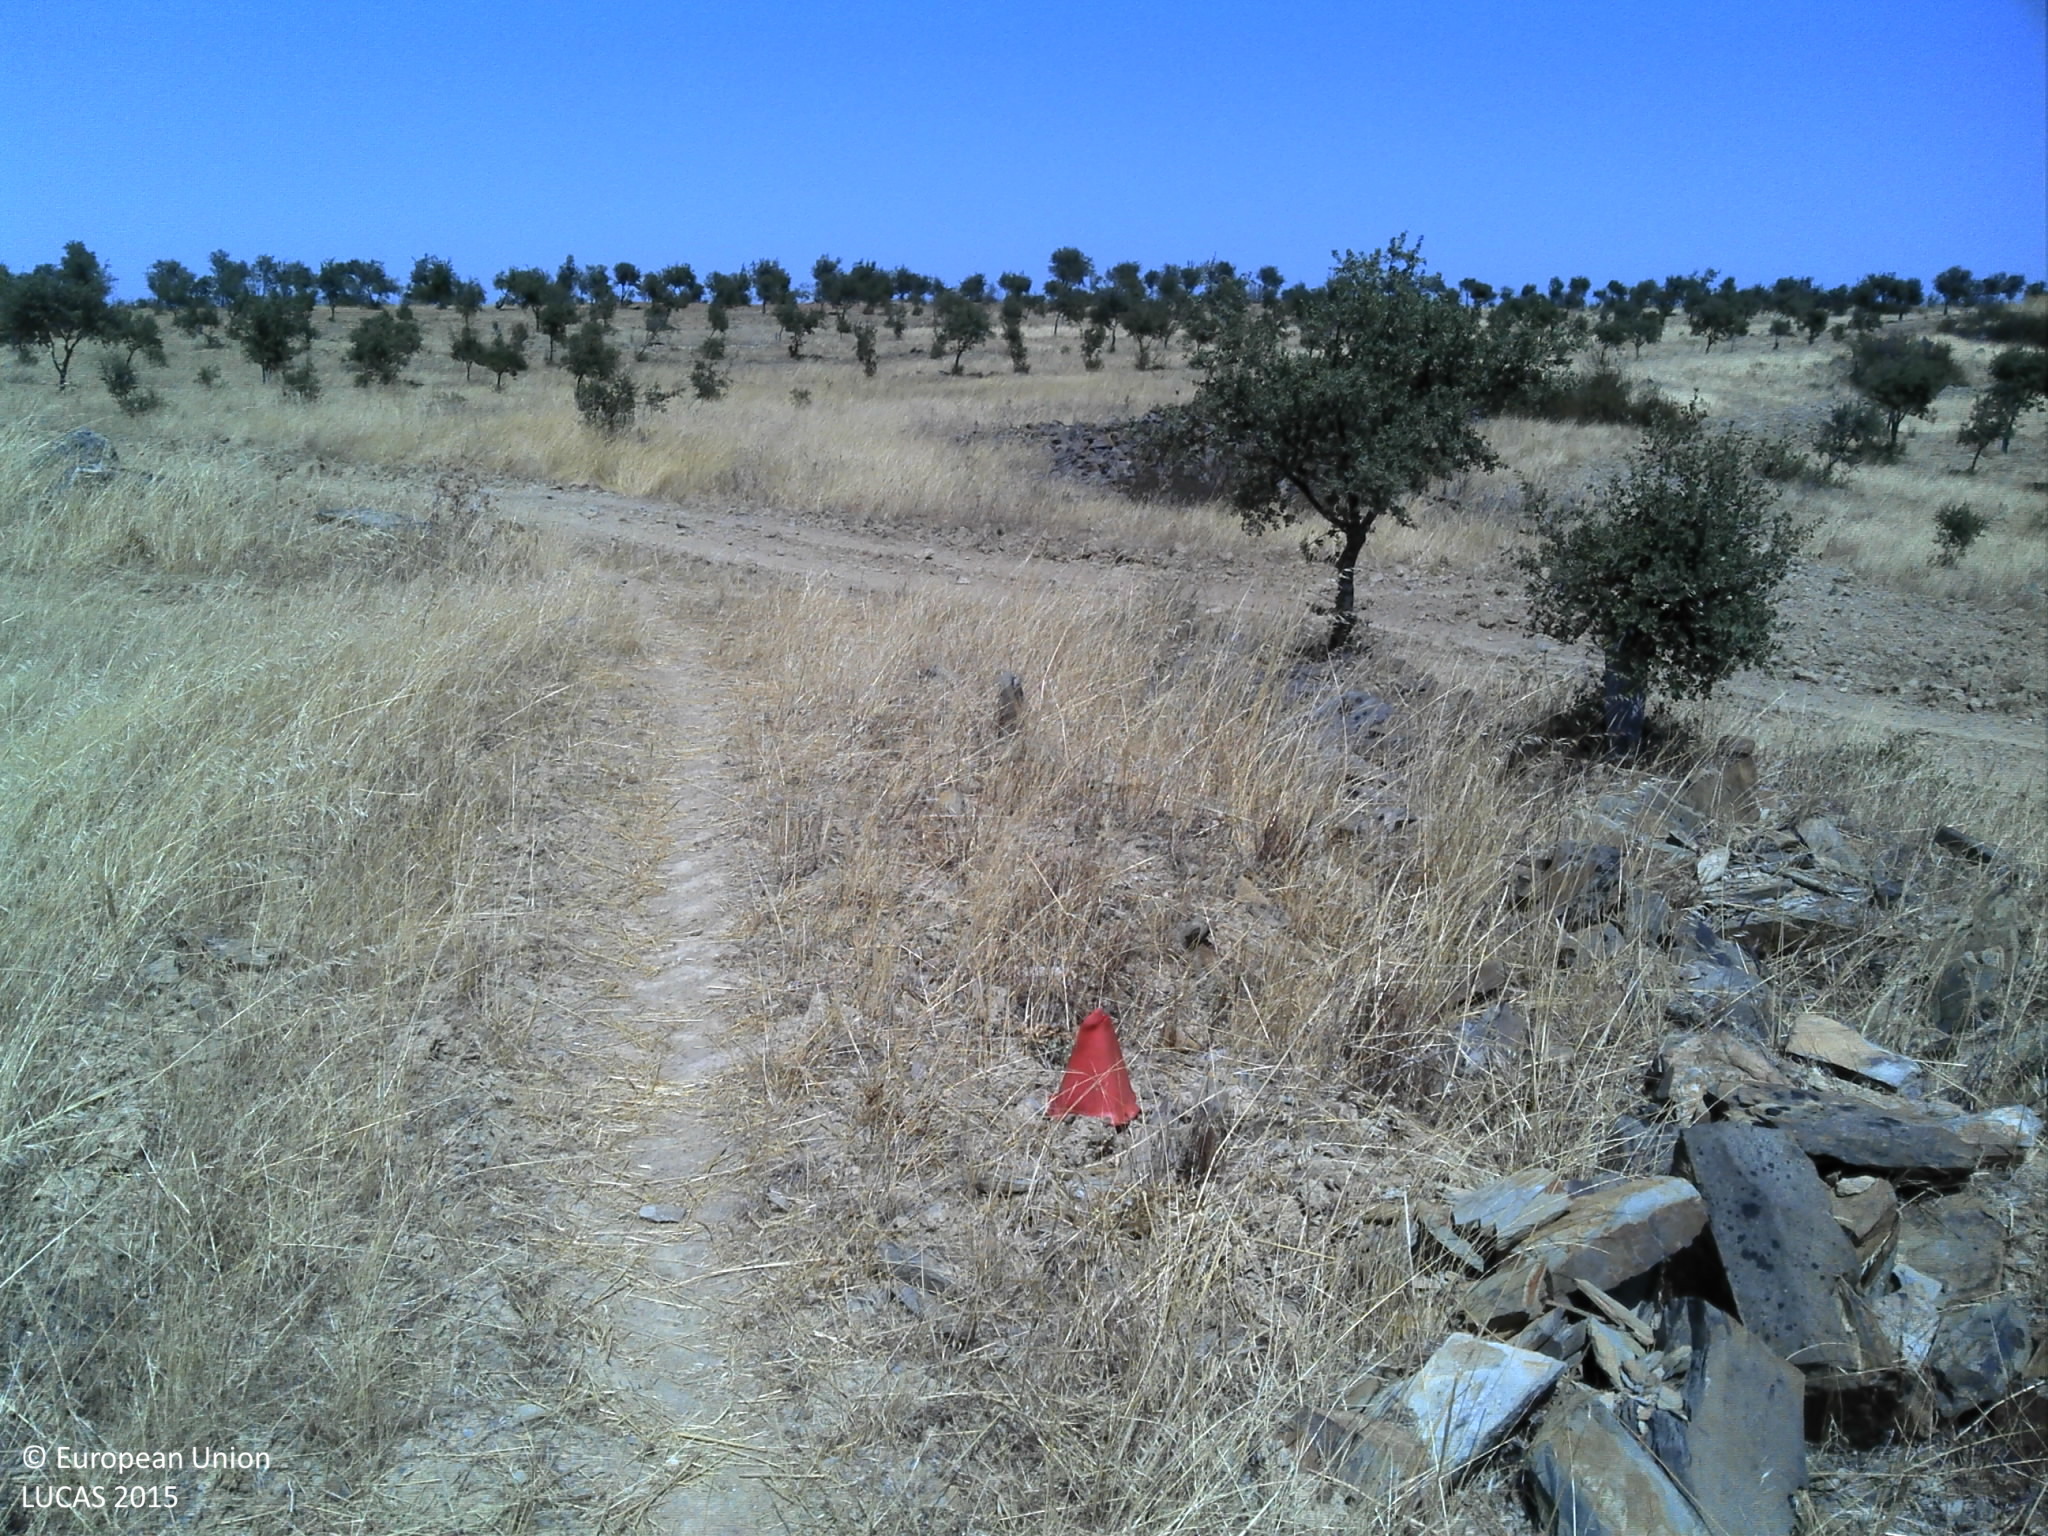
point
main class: Woodland
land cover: Broadleaved woodland
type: broadleaved evergreen forest
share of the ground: 10 - 25 %
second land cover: Grassland without tree/shrub cover
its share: 50 - 75 %
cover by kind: herbaceous plants 60 %, broadleaved forest trees 20 %, unconsolidated bare surface 15 %, consolidated bare surface 5 %
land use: Forestry
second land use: Agriculture (excluding fallow land and kitchen gardens)
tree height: < 5 m
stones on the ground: < 10 %
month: July
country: PT
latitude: 37.6329
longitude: -7.9602
